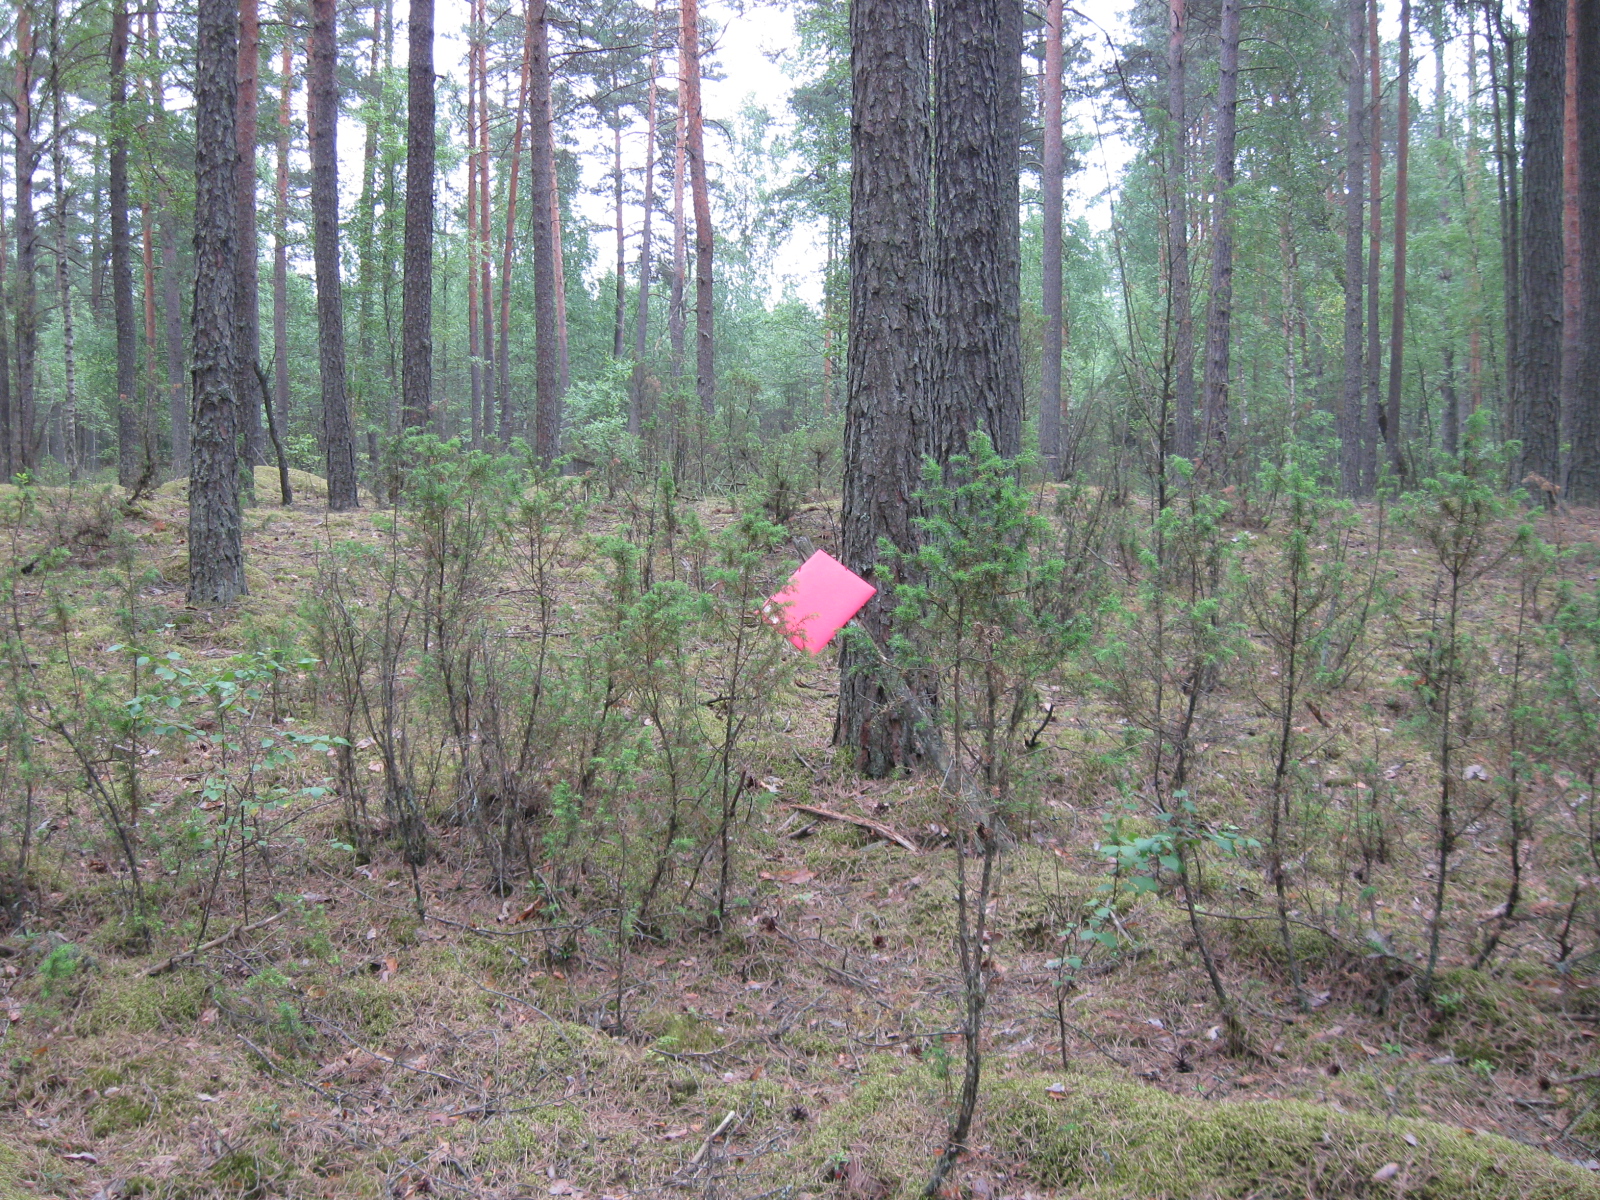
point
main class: Woodland
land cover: Pine dominated coniferous woodland
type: hemiboreal forest and nemoral coniferous forest and mixed broadleaved-coniferous forest
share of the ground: > 75 %
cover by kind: coniferous forest trees 95 %, lichens and mosses 5 %
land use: Forestry
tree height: > 5 m
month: July
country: LT
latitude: 54.1388
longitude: 24.2883
